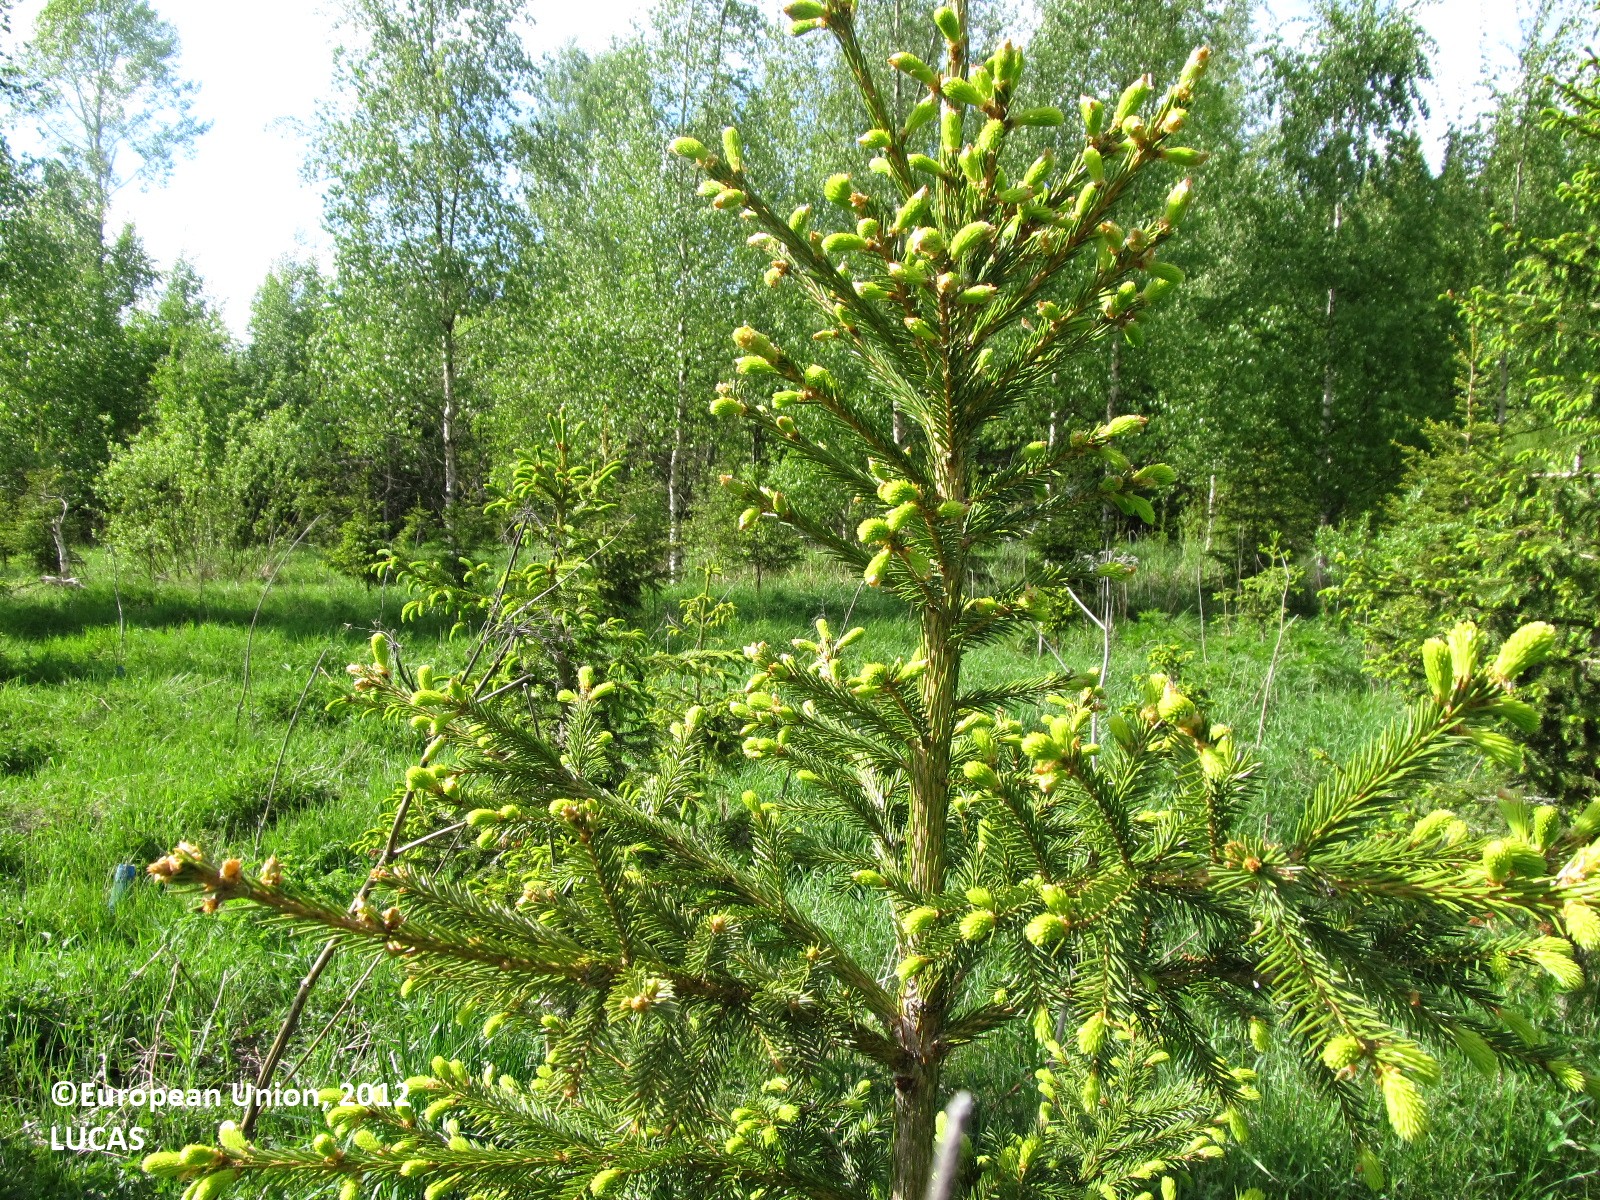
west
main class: Woodland
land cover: Spruce dominated coniferous woodland
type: boreal forest
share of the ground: 10 - 25 %
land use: Forestry
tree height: < 5 m
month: June
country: FI
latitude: 62.5294
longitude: 28.6469
